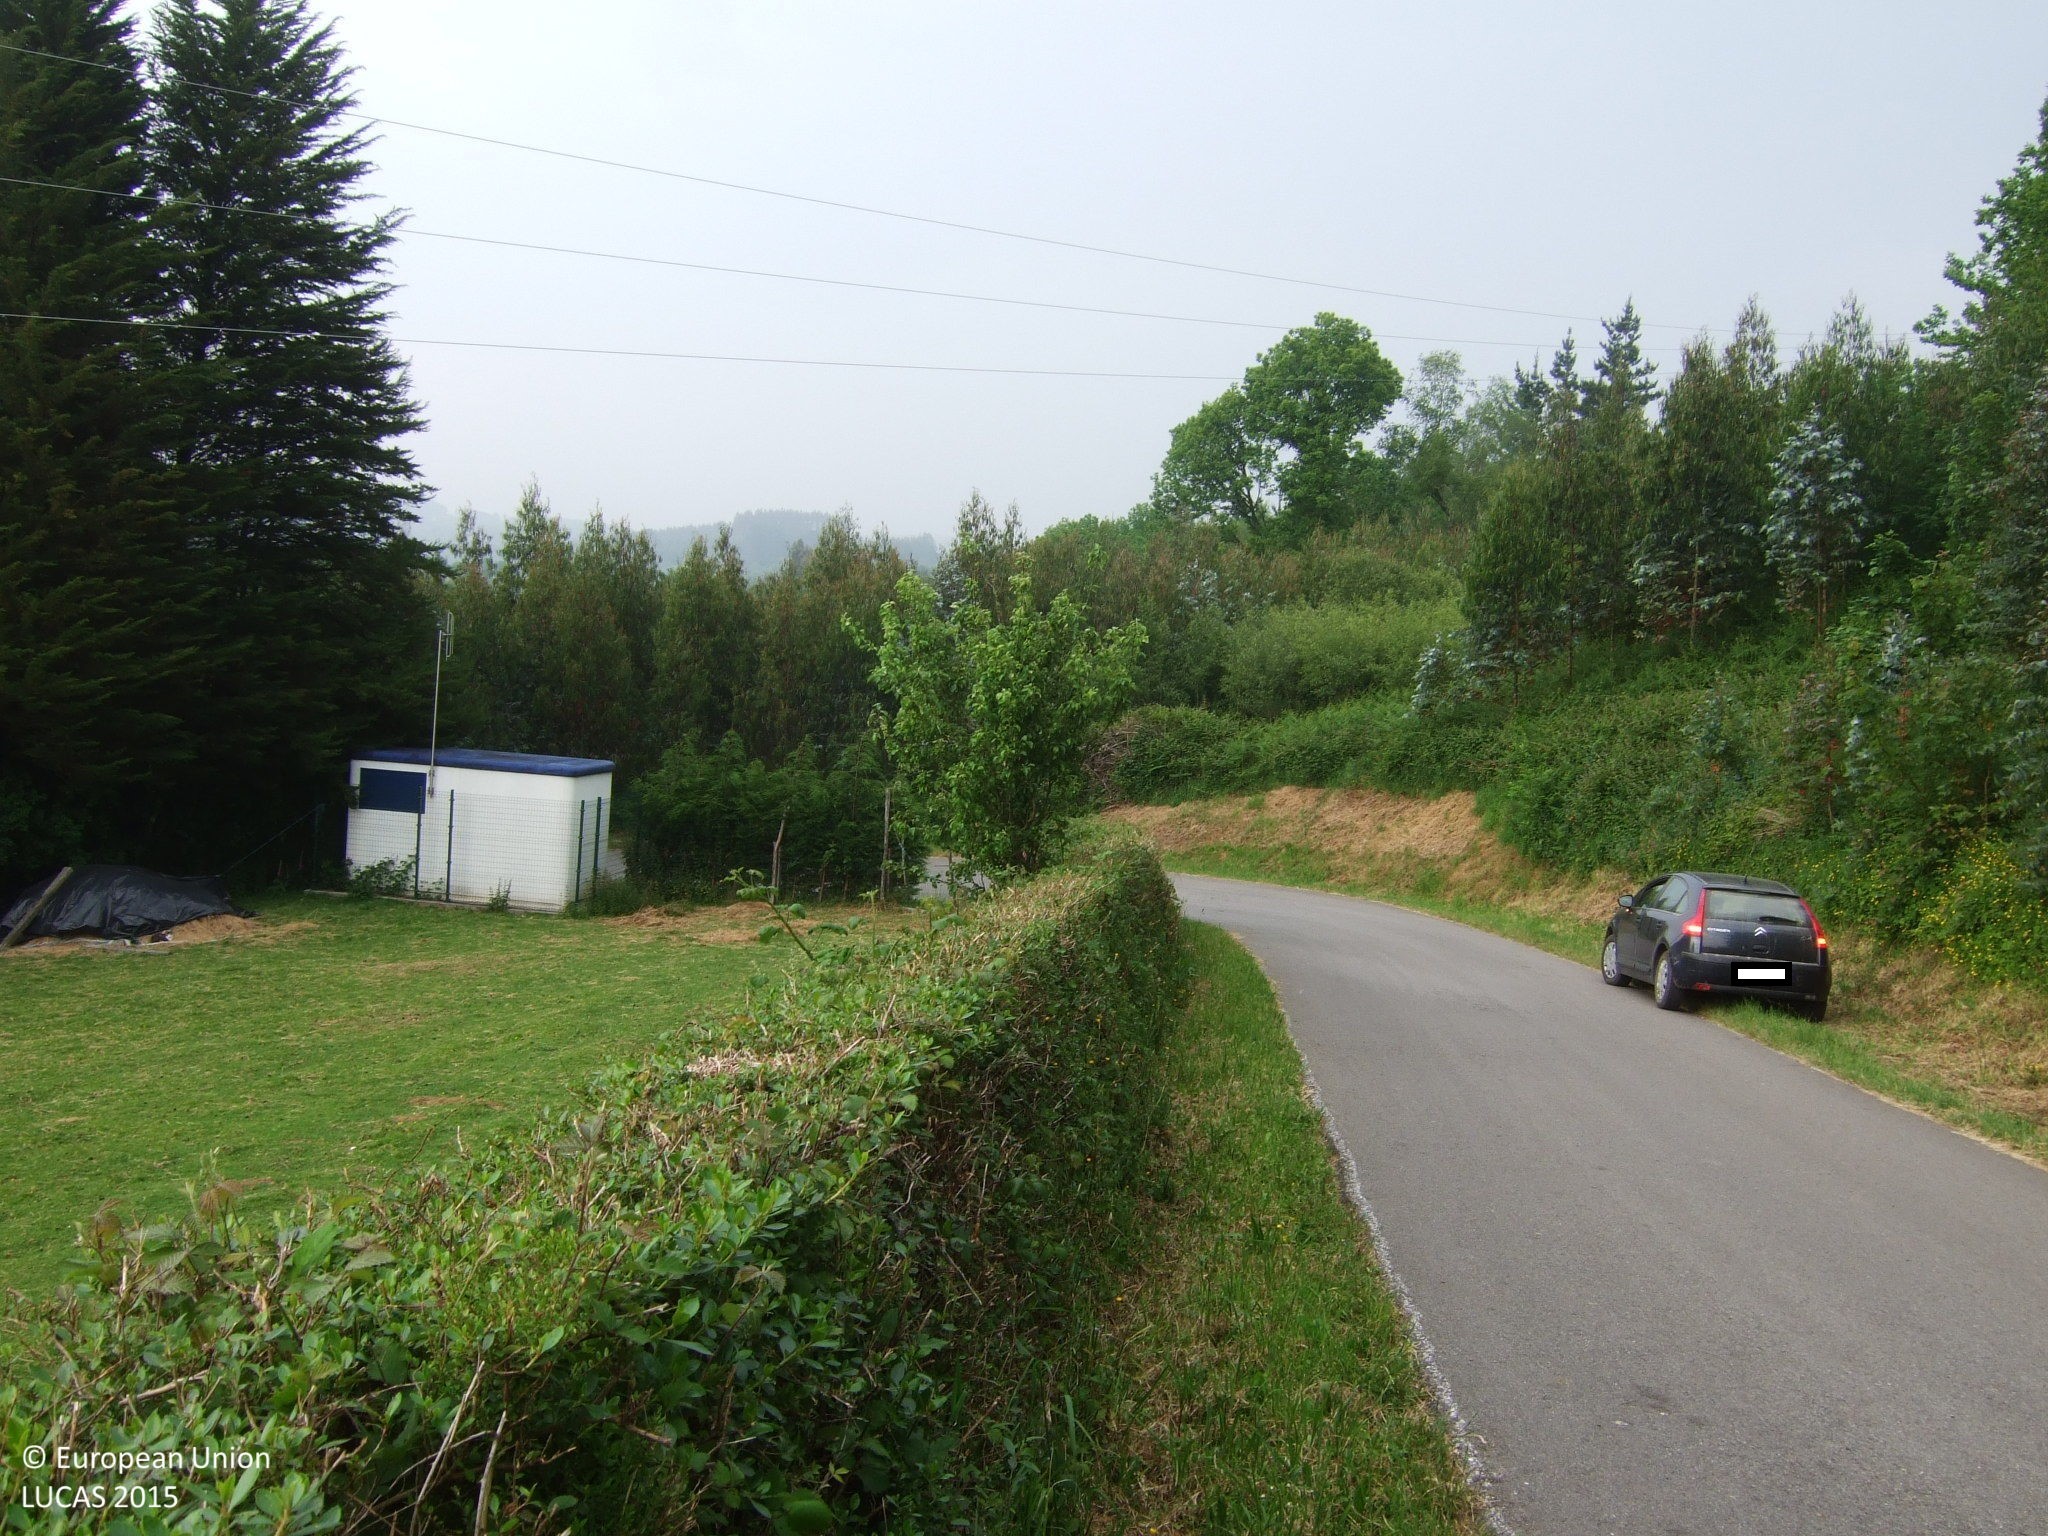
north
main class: Grassland
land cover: Grassland without tree/shrub cover
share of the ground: > 75 %
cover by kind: herbaceous plants 100 %
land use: Agriculture (excluding fallow land and kitchen gardens)
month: June
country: ES
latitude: 43.3706
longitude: -7.4678
